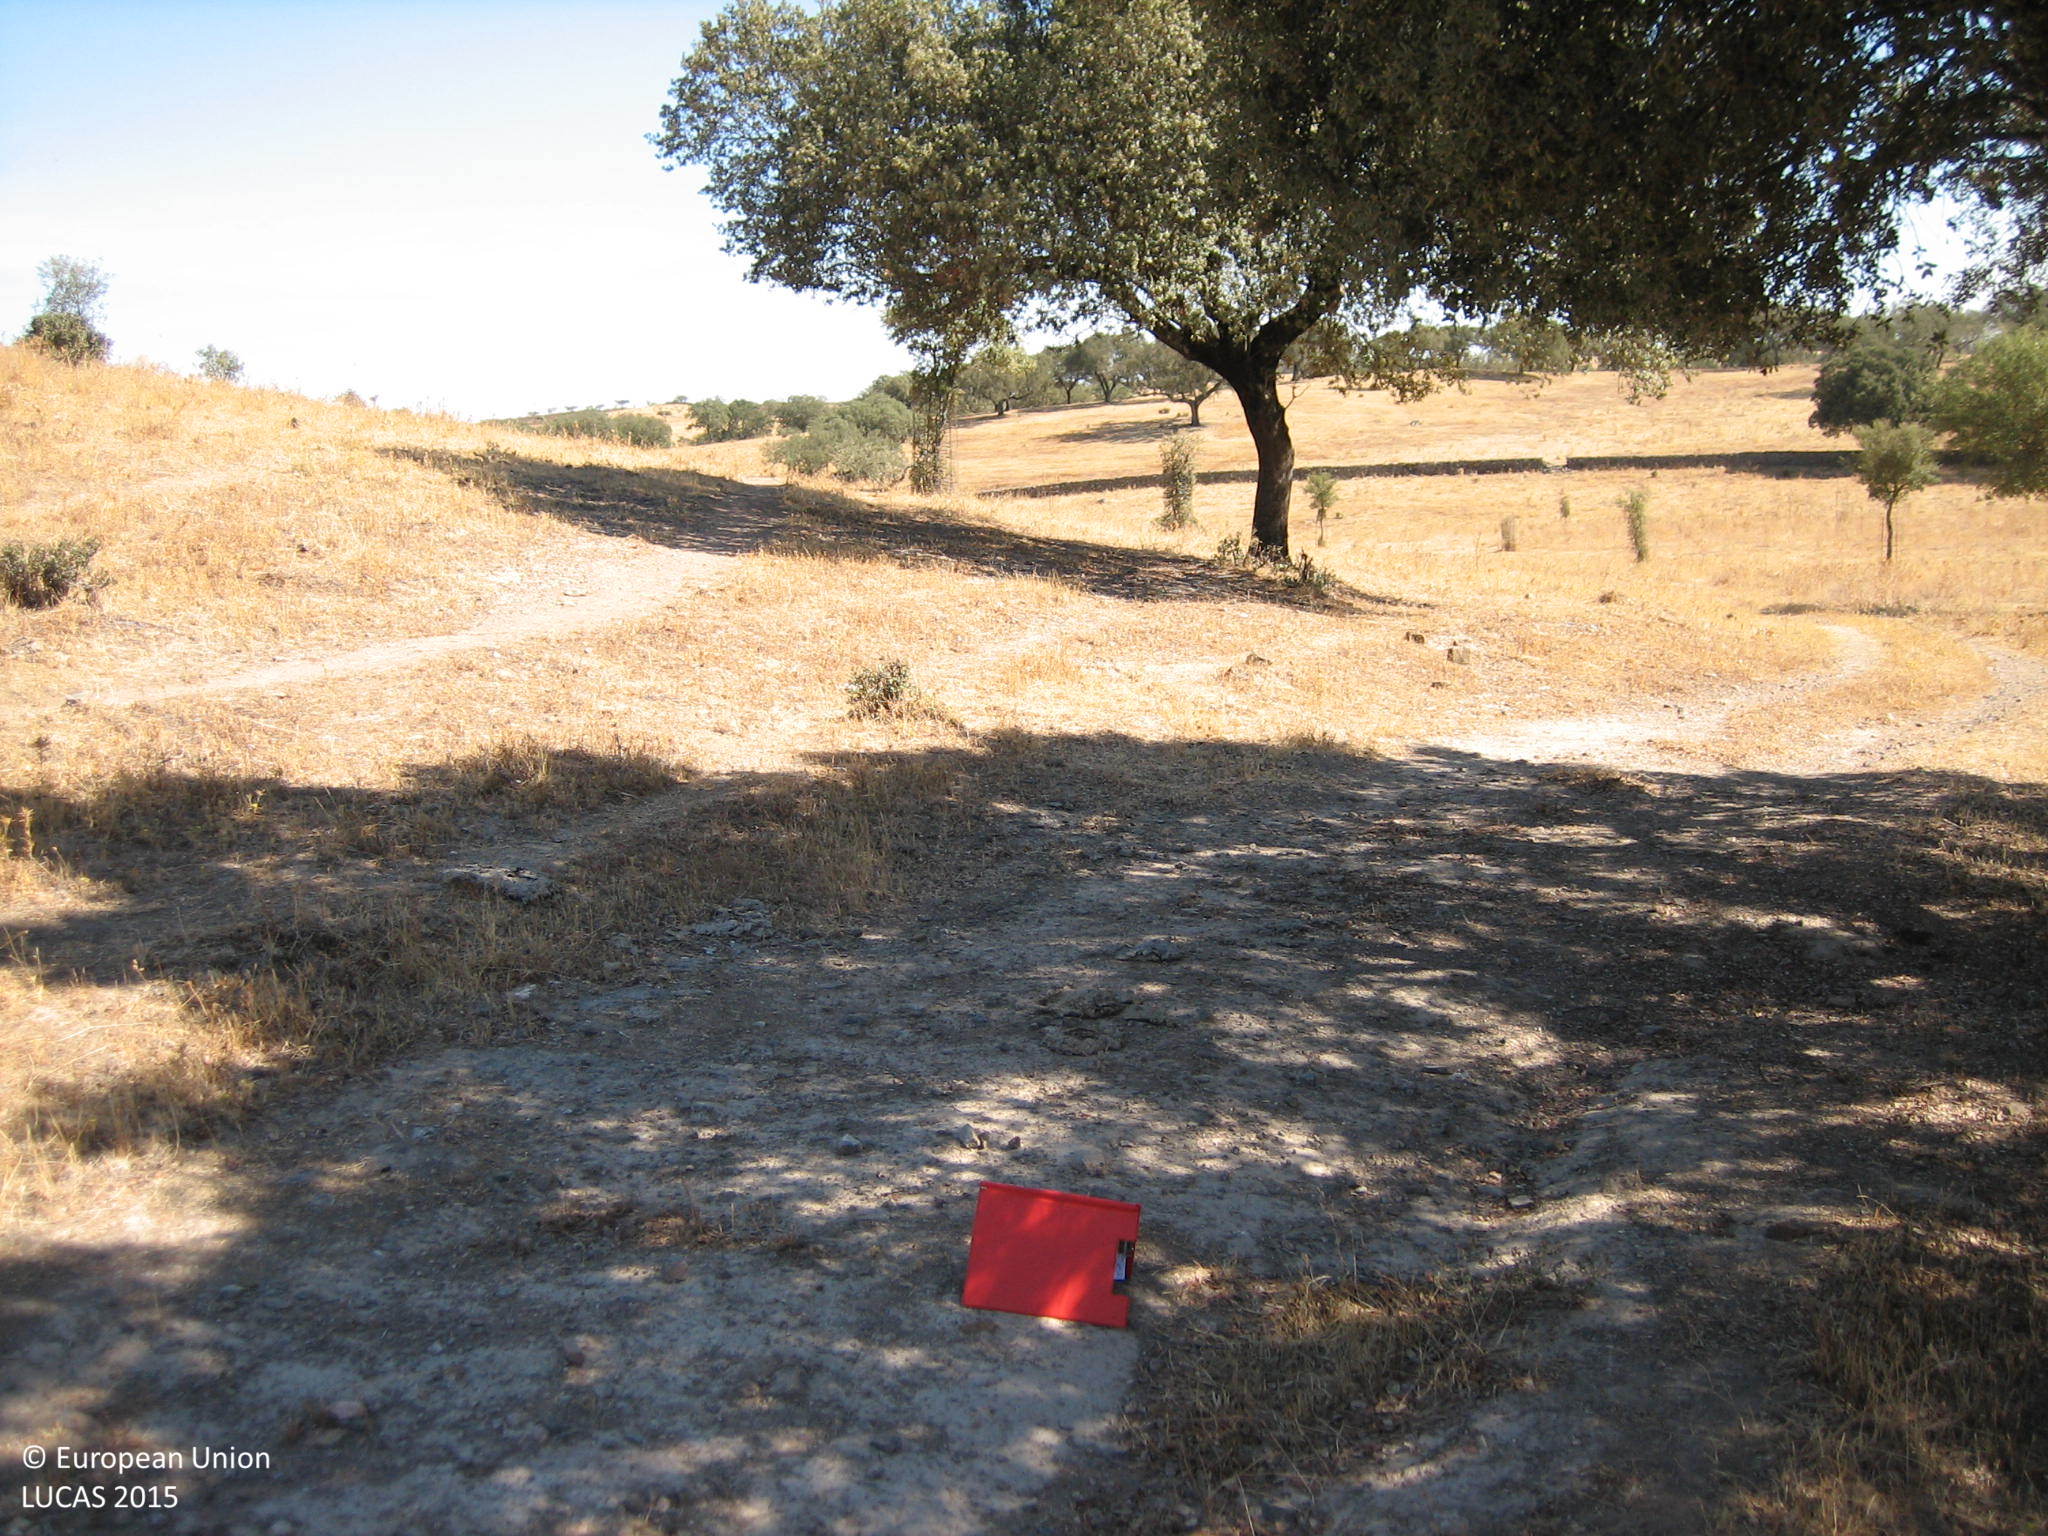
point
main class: Grassland
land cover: Grassland with sparse tree/shrub cover
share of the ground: > 75 %
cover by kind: herbaceous plants 95 %, broadleaved forest trees 5 %
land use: Forestry
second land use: Agriculture (excluding fallow land and kitchen gardens)
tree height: < 5 m
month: August
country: ES
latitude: 38.5332
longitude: -7.1954
